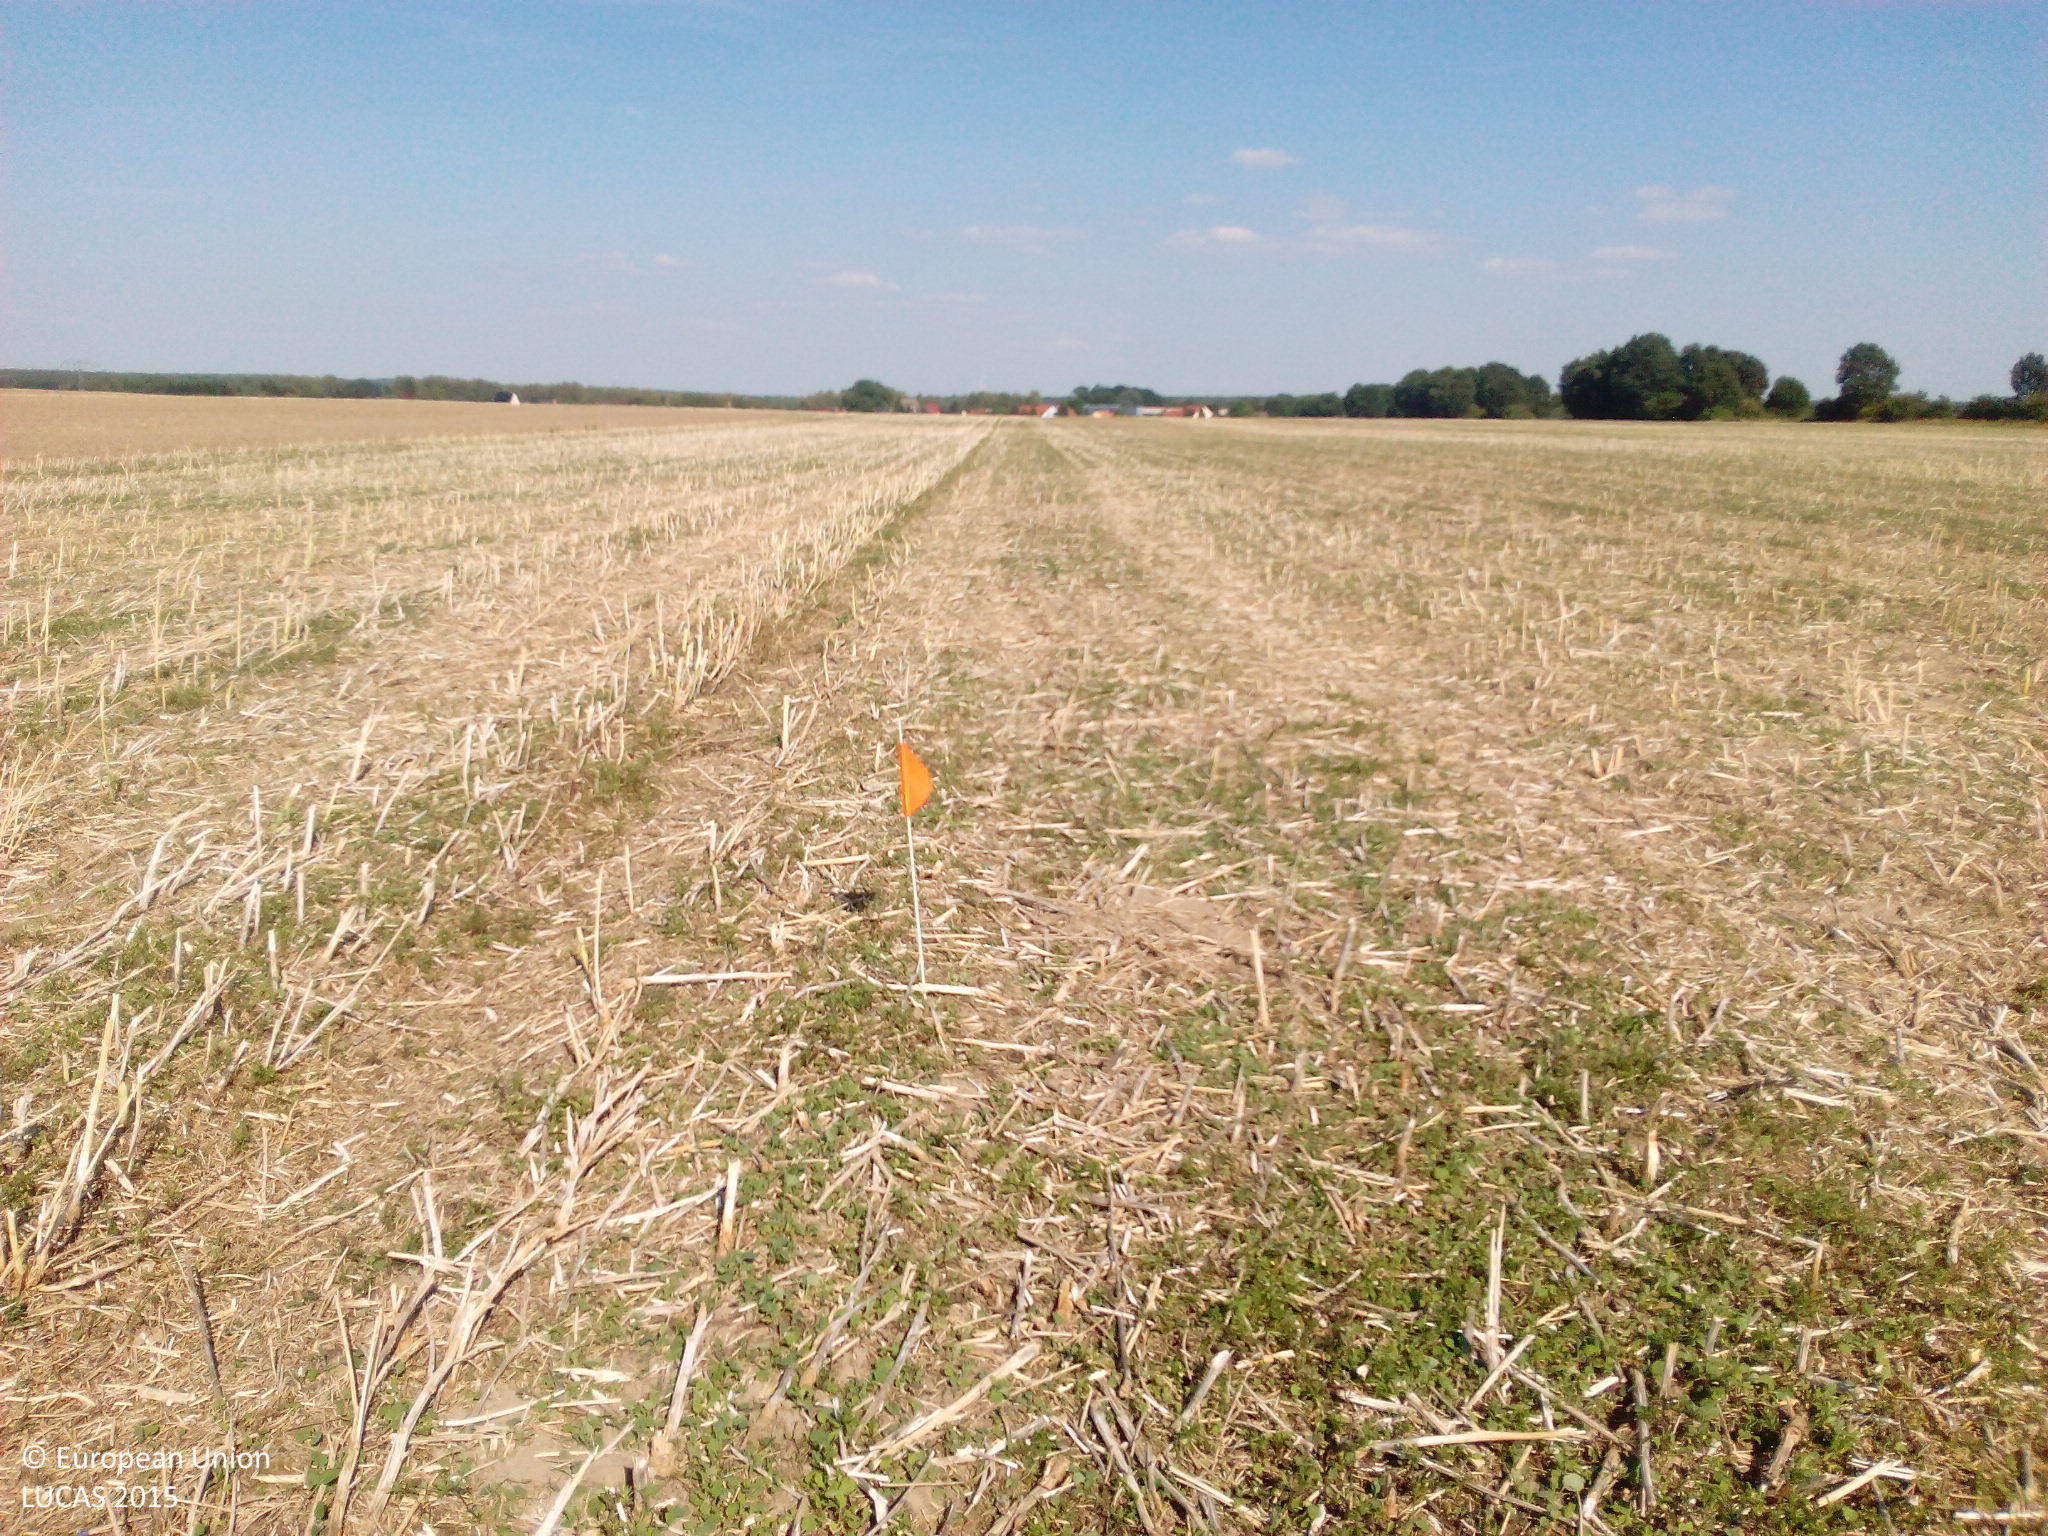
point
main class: Cropland
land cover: Rape and turnip rape
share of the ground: 10 - 25 %
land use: Agriculture (excluding fallow land and kitchen gardens)
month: August
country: DE
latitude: 51.9757
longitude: 13.1591
